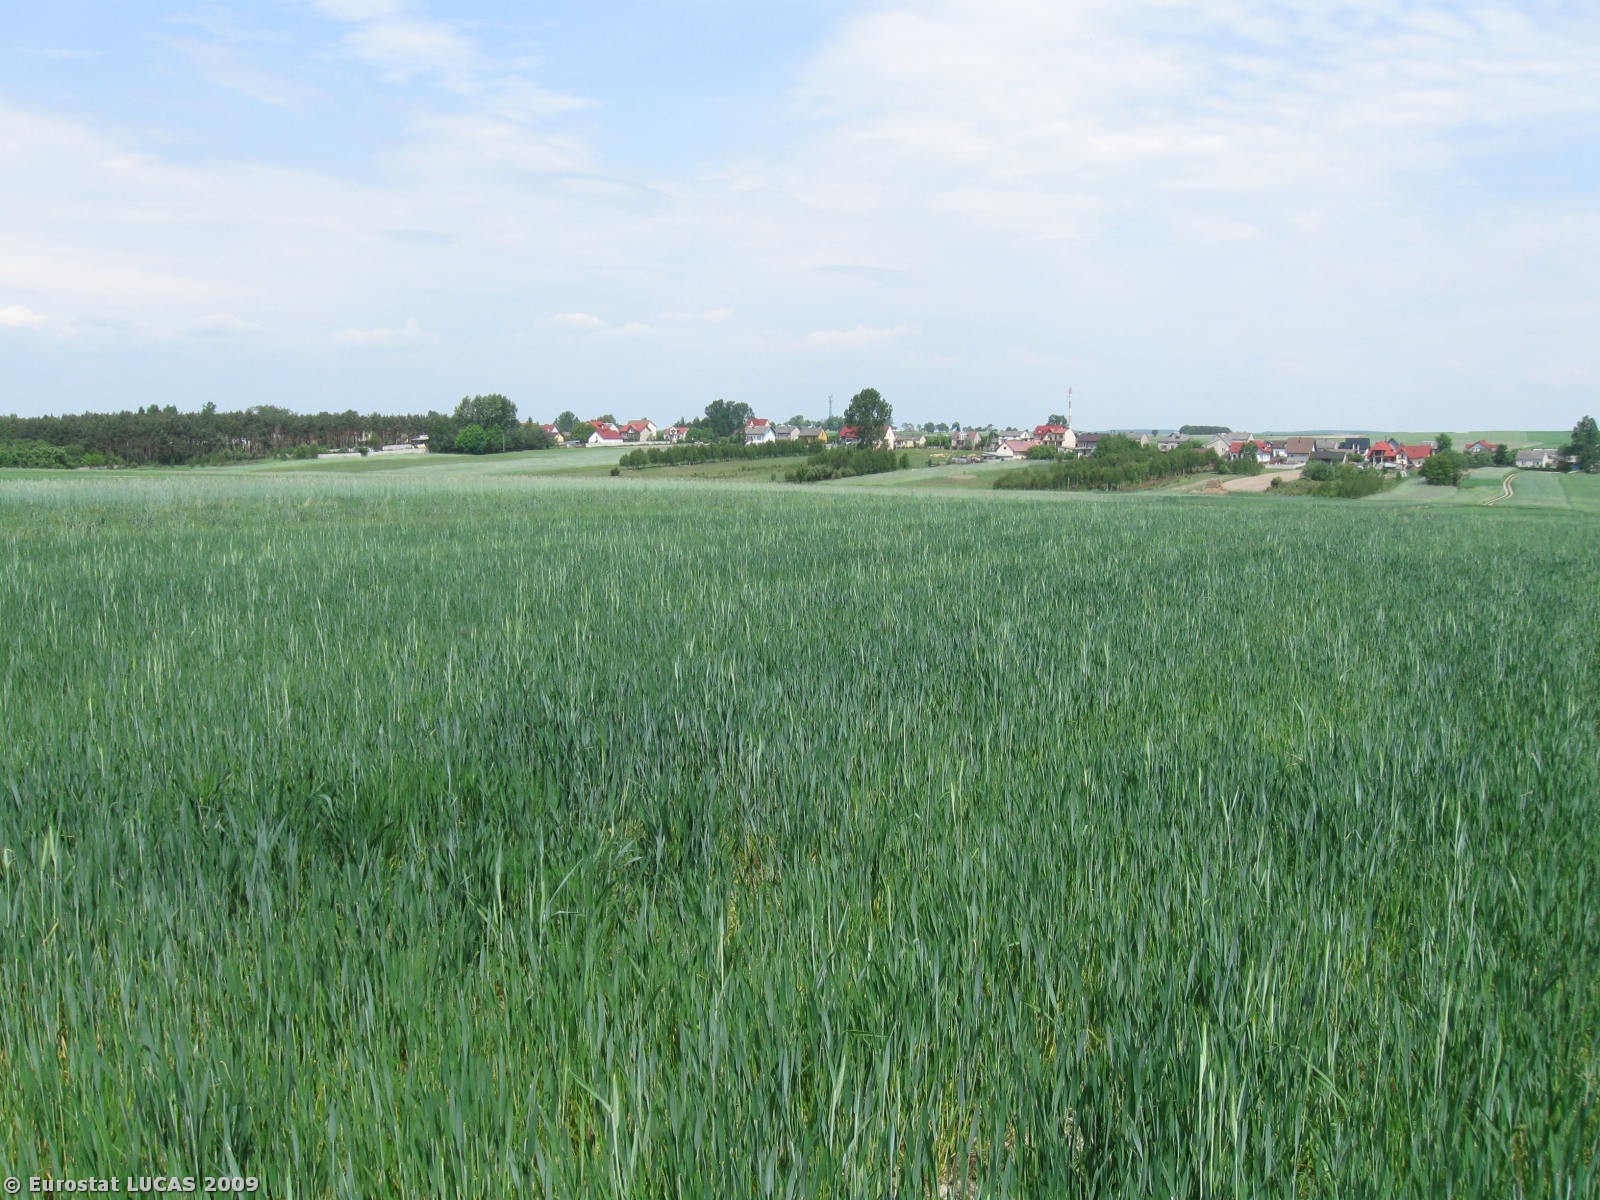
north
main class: Cropland
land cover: Rye
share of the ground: > 75 %
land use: Agriculture (excluding fallow land and kitchen gardens)
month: May
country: PL
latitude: 50.7057
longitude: 20.3879
